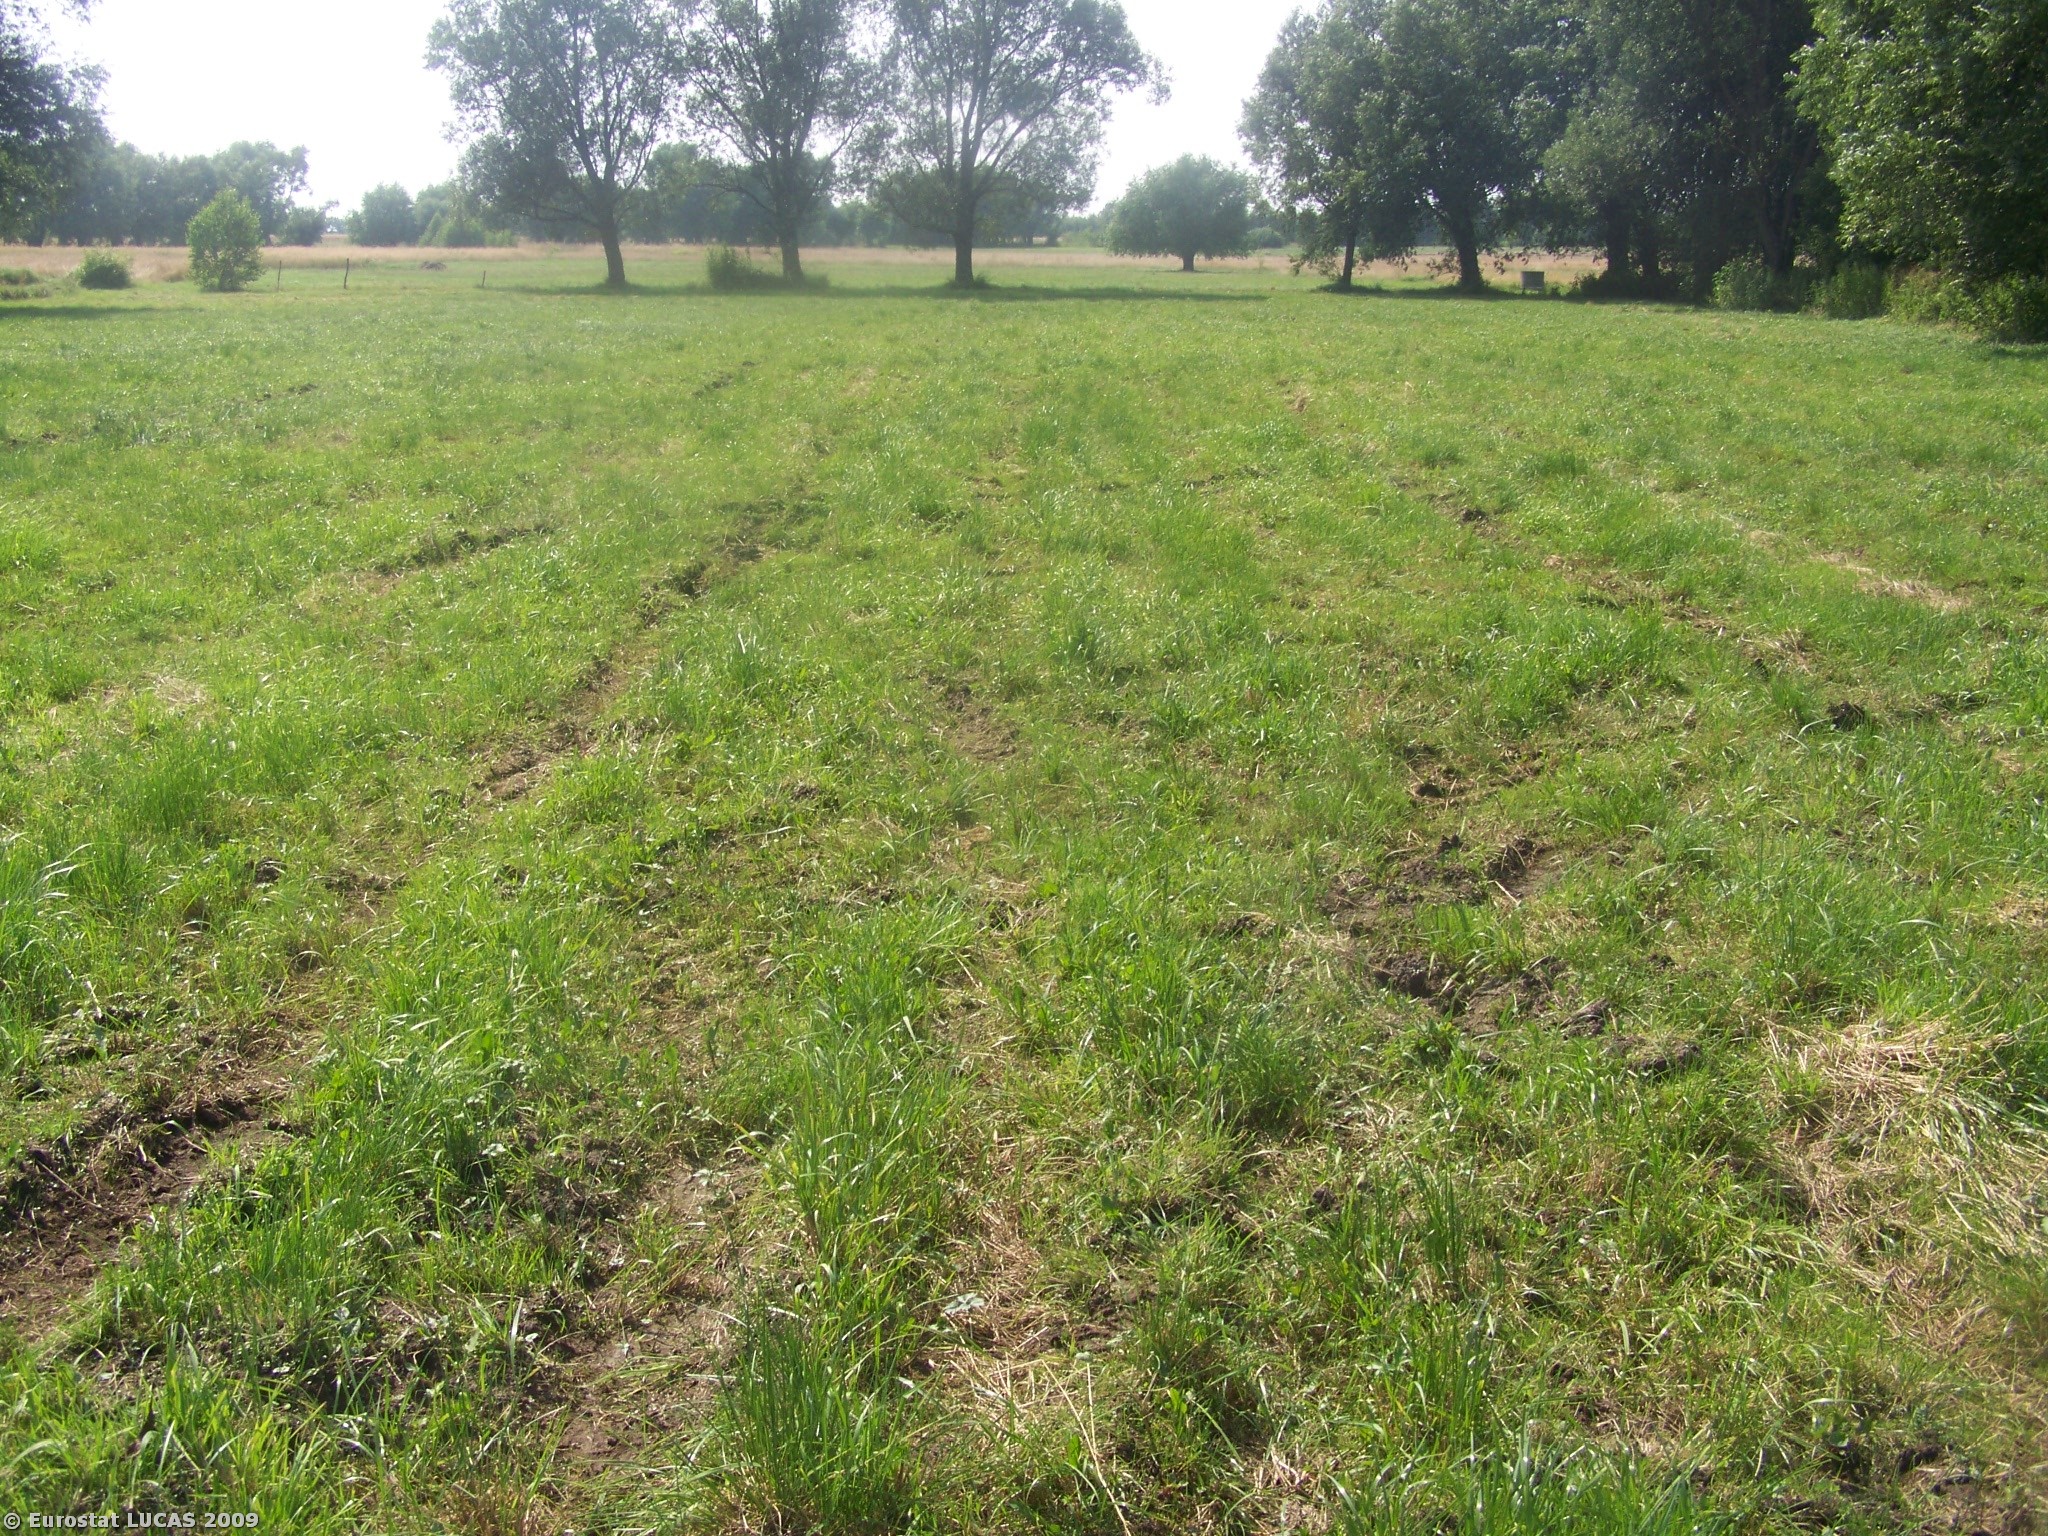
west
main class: Grassland
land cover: Grassland without tree/shrub cover
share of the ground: > 75 %
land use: Agriculture (excluding fallow land and kitchen gardens)
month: July
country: PL
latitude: 51.9648
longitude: 21.6532
